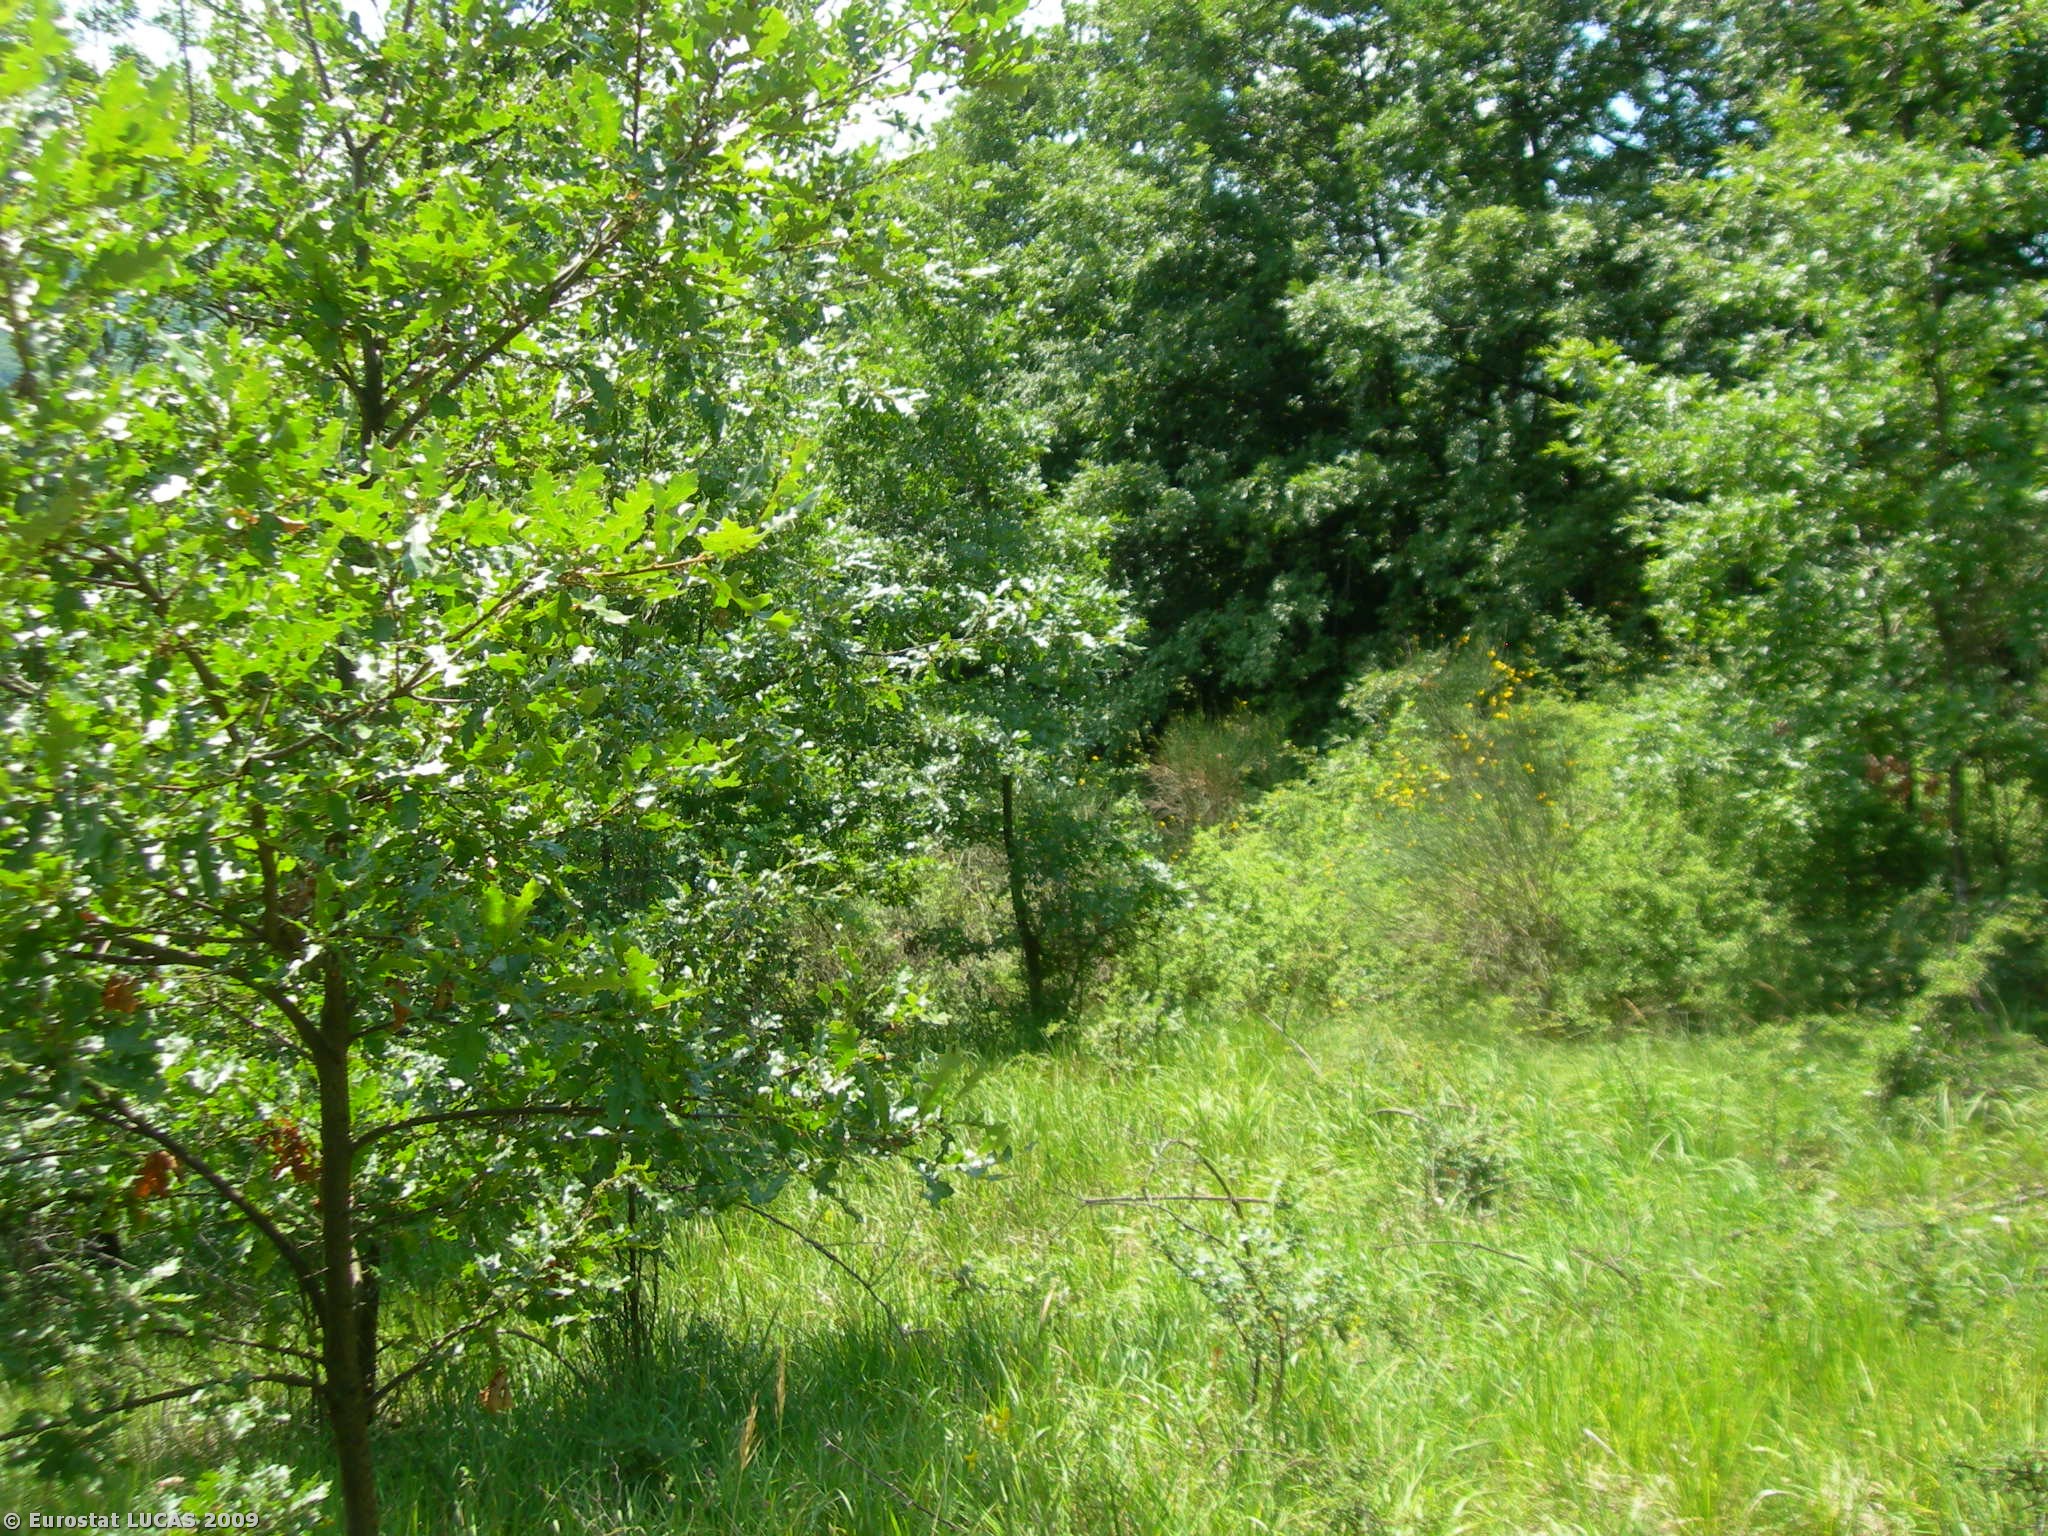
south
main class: Shrubland
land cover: Shrubland with sparse tree cover
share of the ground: > 75 %
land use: Fallow land
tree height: < 5 m
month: June
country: IT
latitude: 44.1078
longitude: 11.3087
